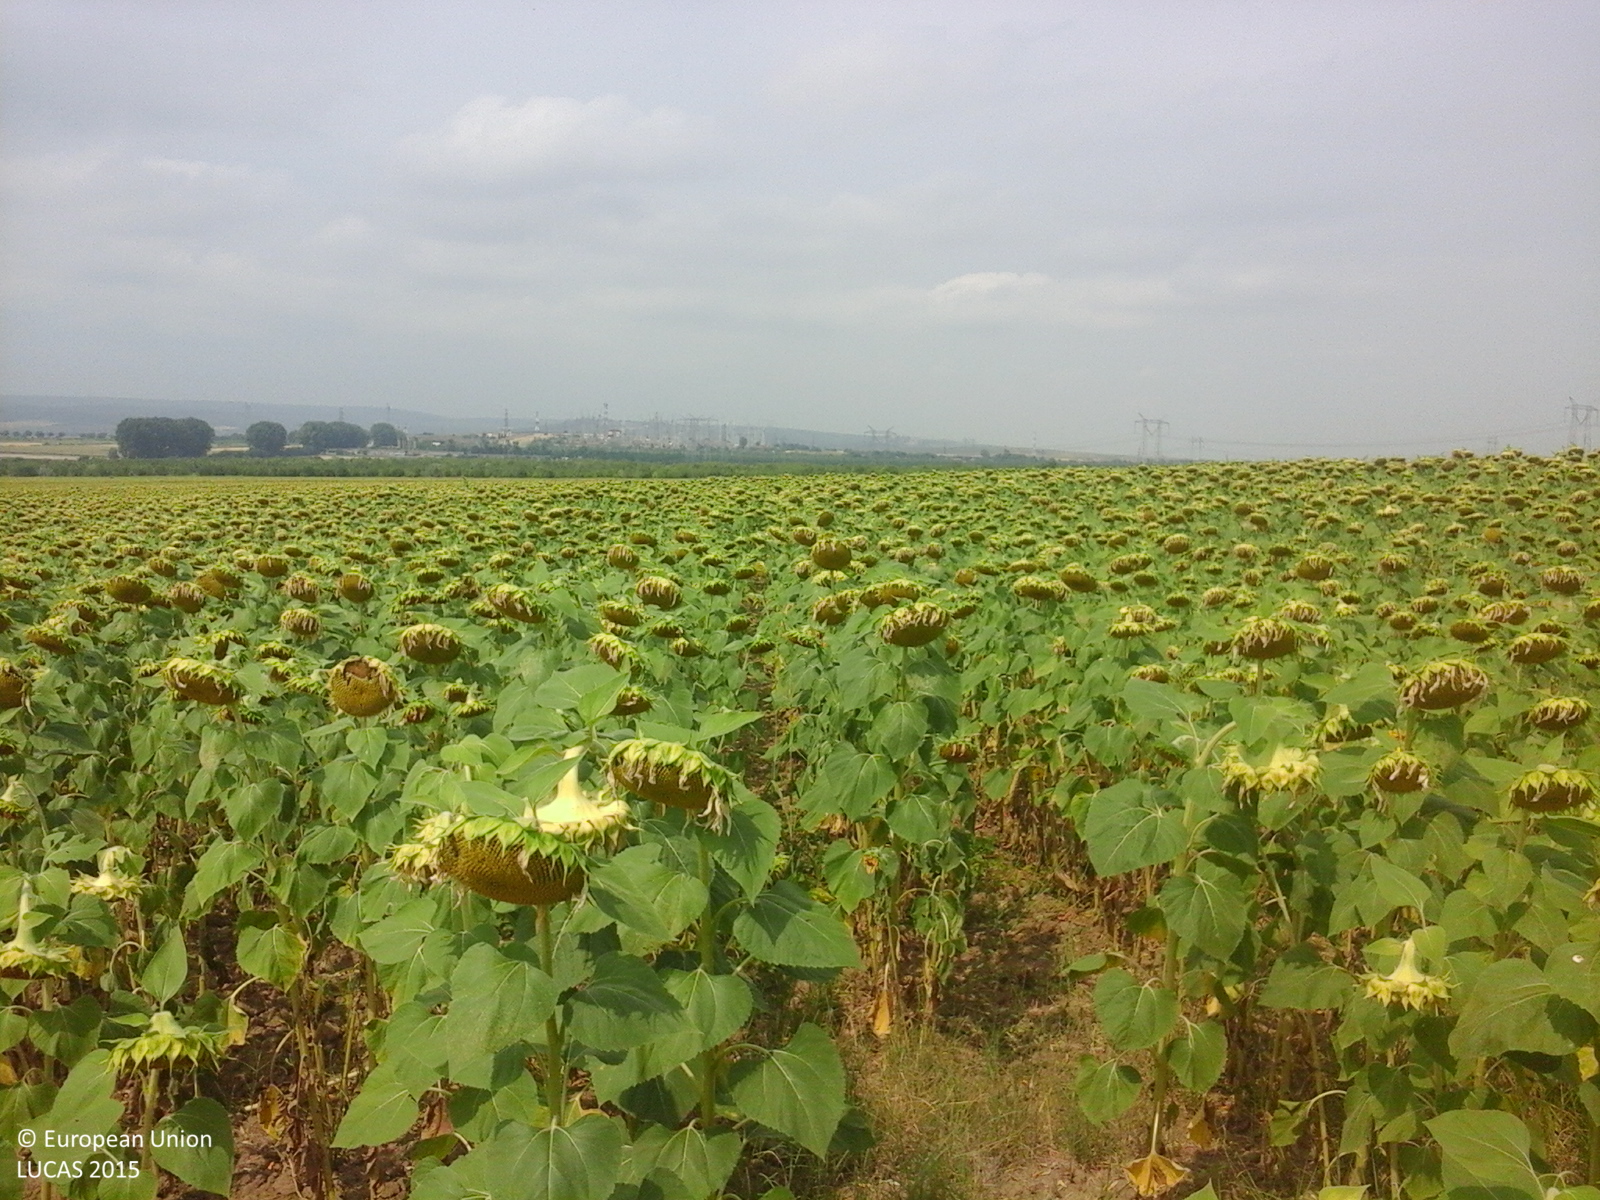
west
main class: Cropland
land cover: Sunflower
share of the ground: > 75 %
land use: Agriculture (excluding fallow land and kitchen gardens)
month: July
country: RO
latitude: 45.2555
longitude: 28.4934
